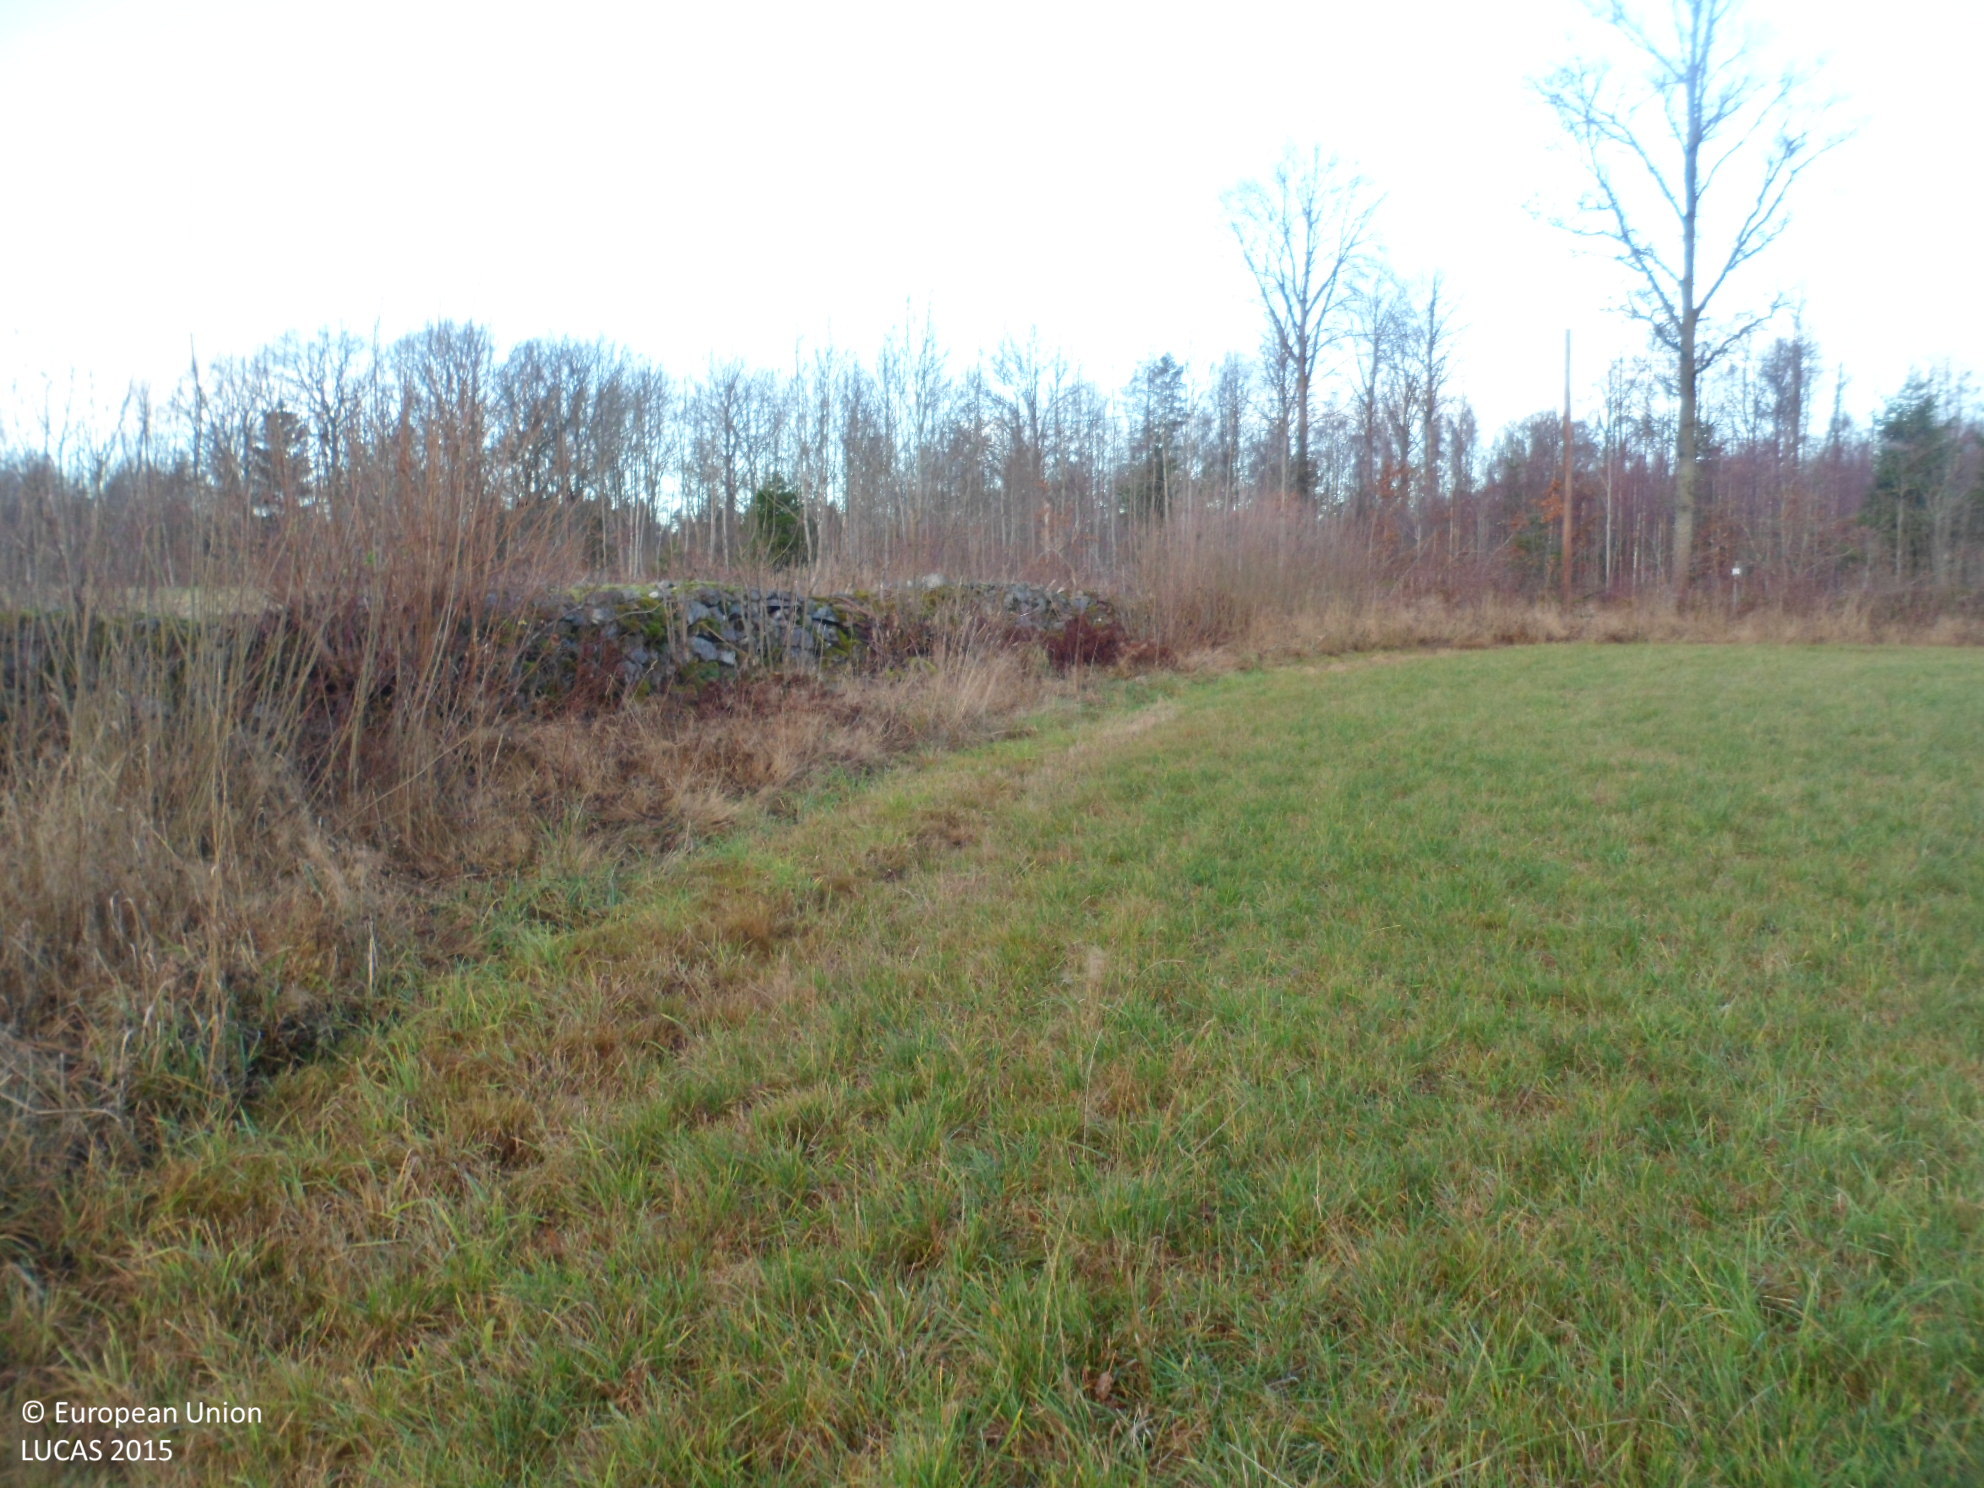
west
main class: Grassland
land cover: Grassland without tree/shrub cover
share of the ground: > 75 %
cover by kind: herbaceous plants 100 %
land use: Agriculture (excluding fallow land and kitchen gardens)
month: November
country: SE
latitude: 56.9536
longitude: 15.9017
